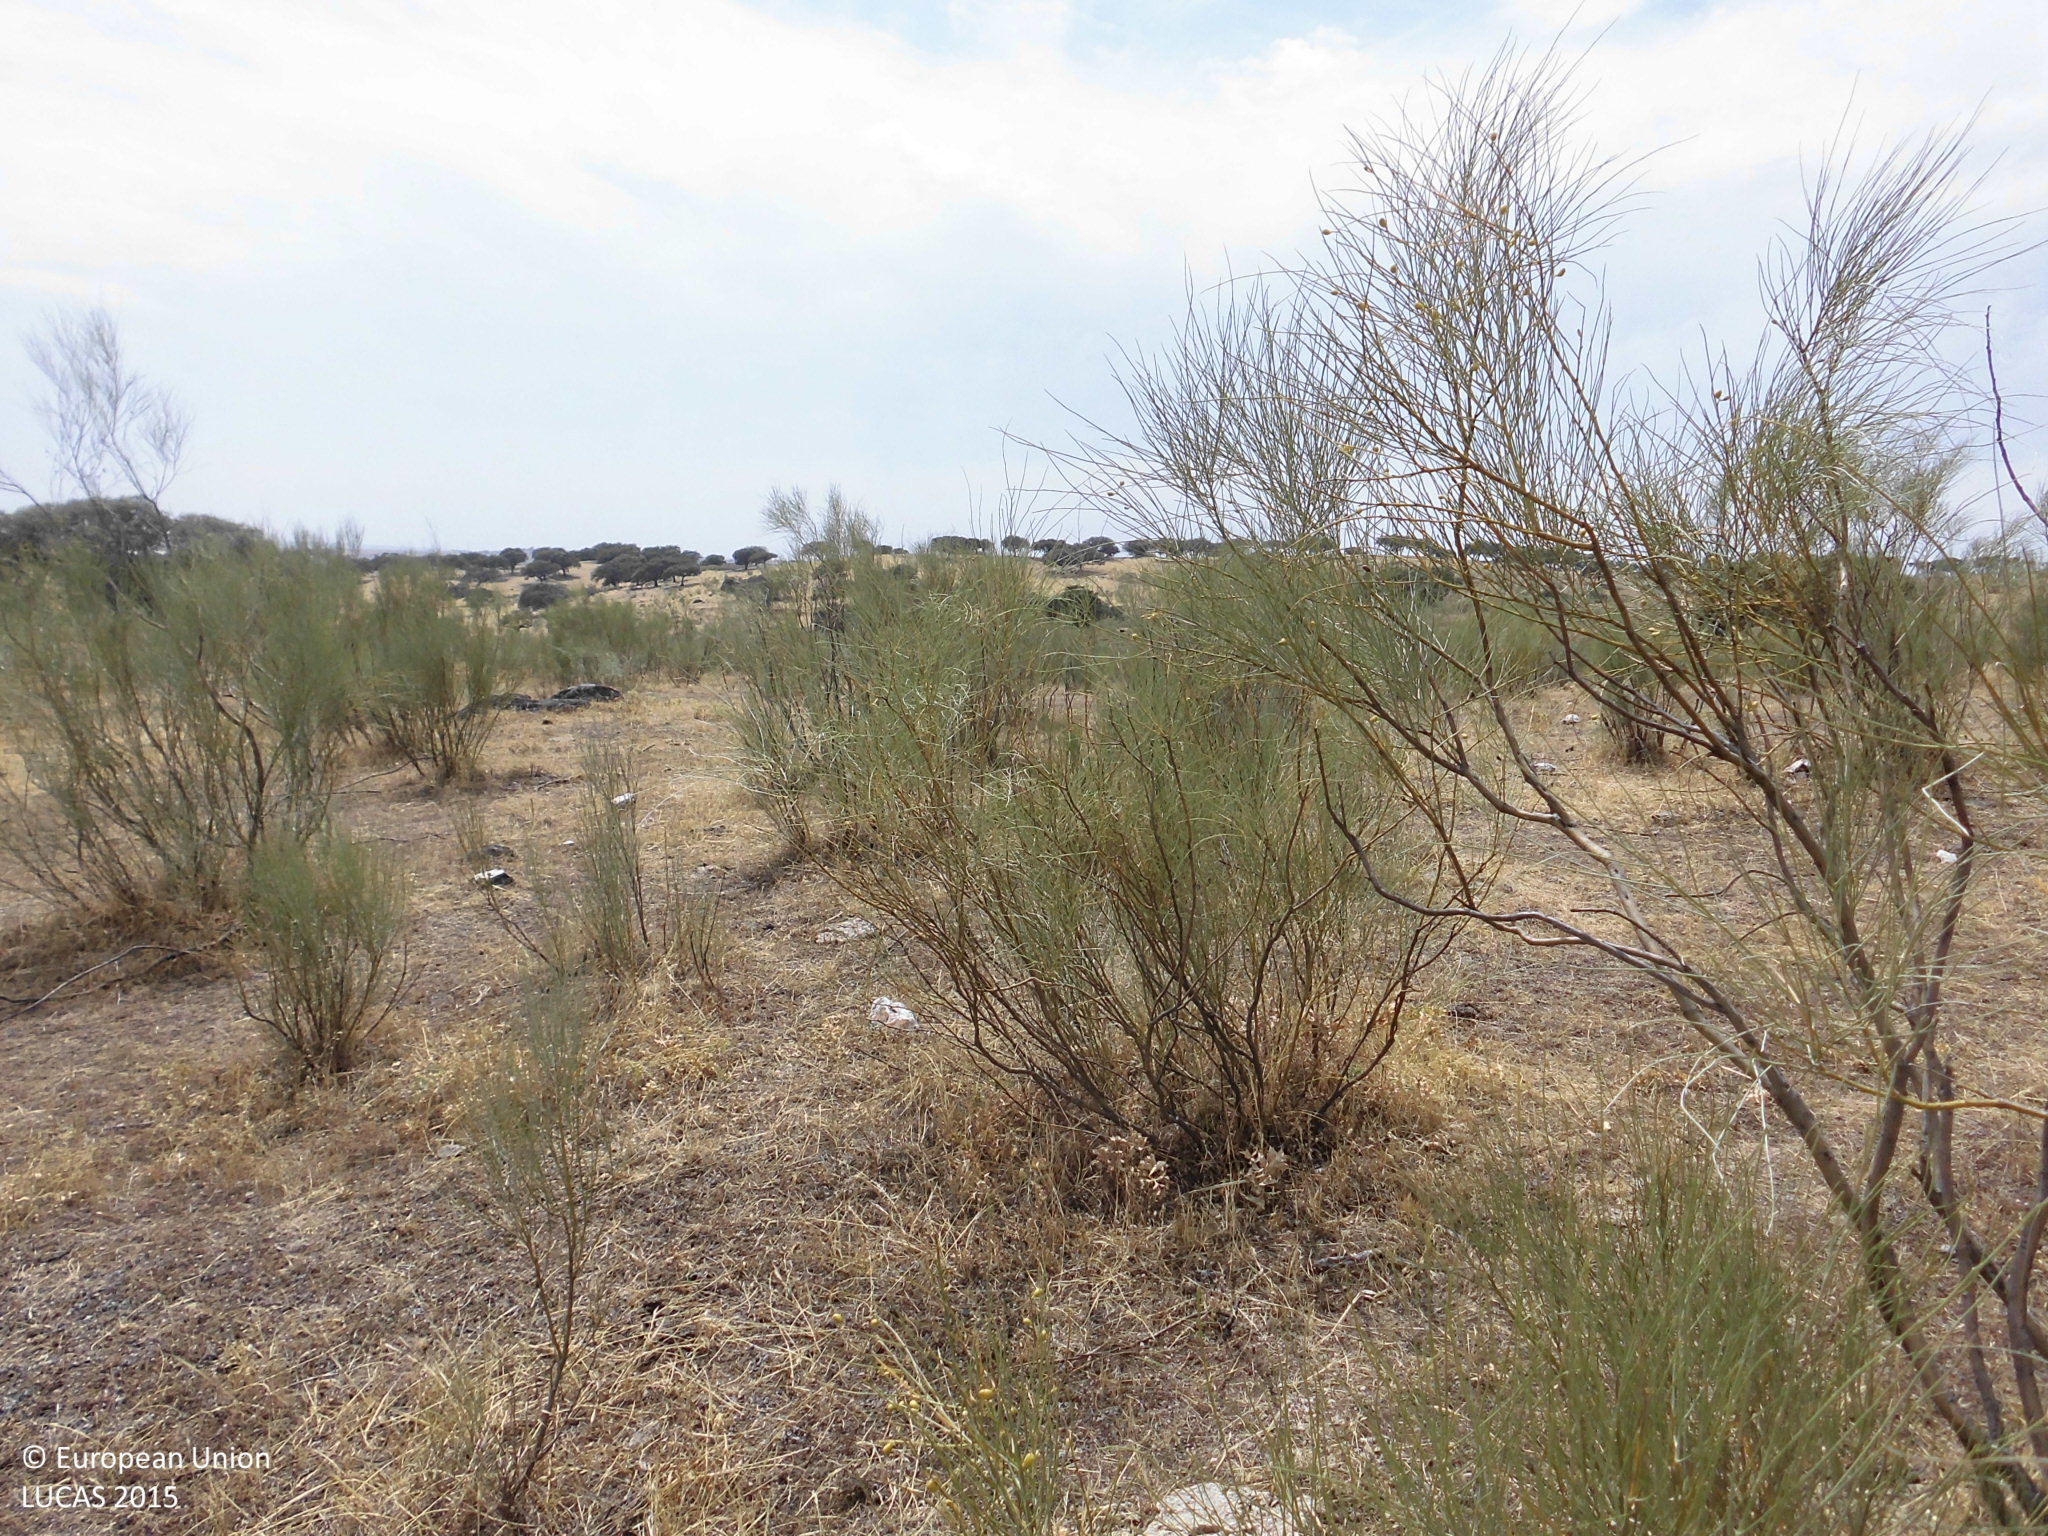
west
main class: Shrubland
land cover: Shrubland without tree cover
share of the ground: 10 - 25 %
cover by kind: herbaceous plants 85 %, shrubs 15 %
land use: Agriculture (excluding fallow land and kitchen gardens)
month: July
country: ES
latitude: 39.7876
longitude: -6.4581
